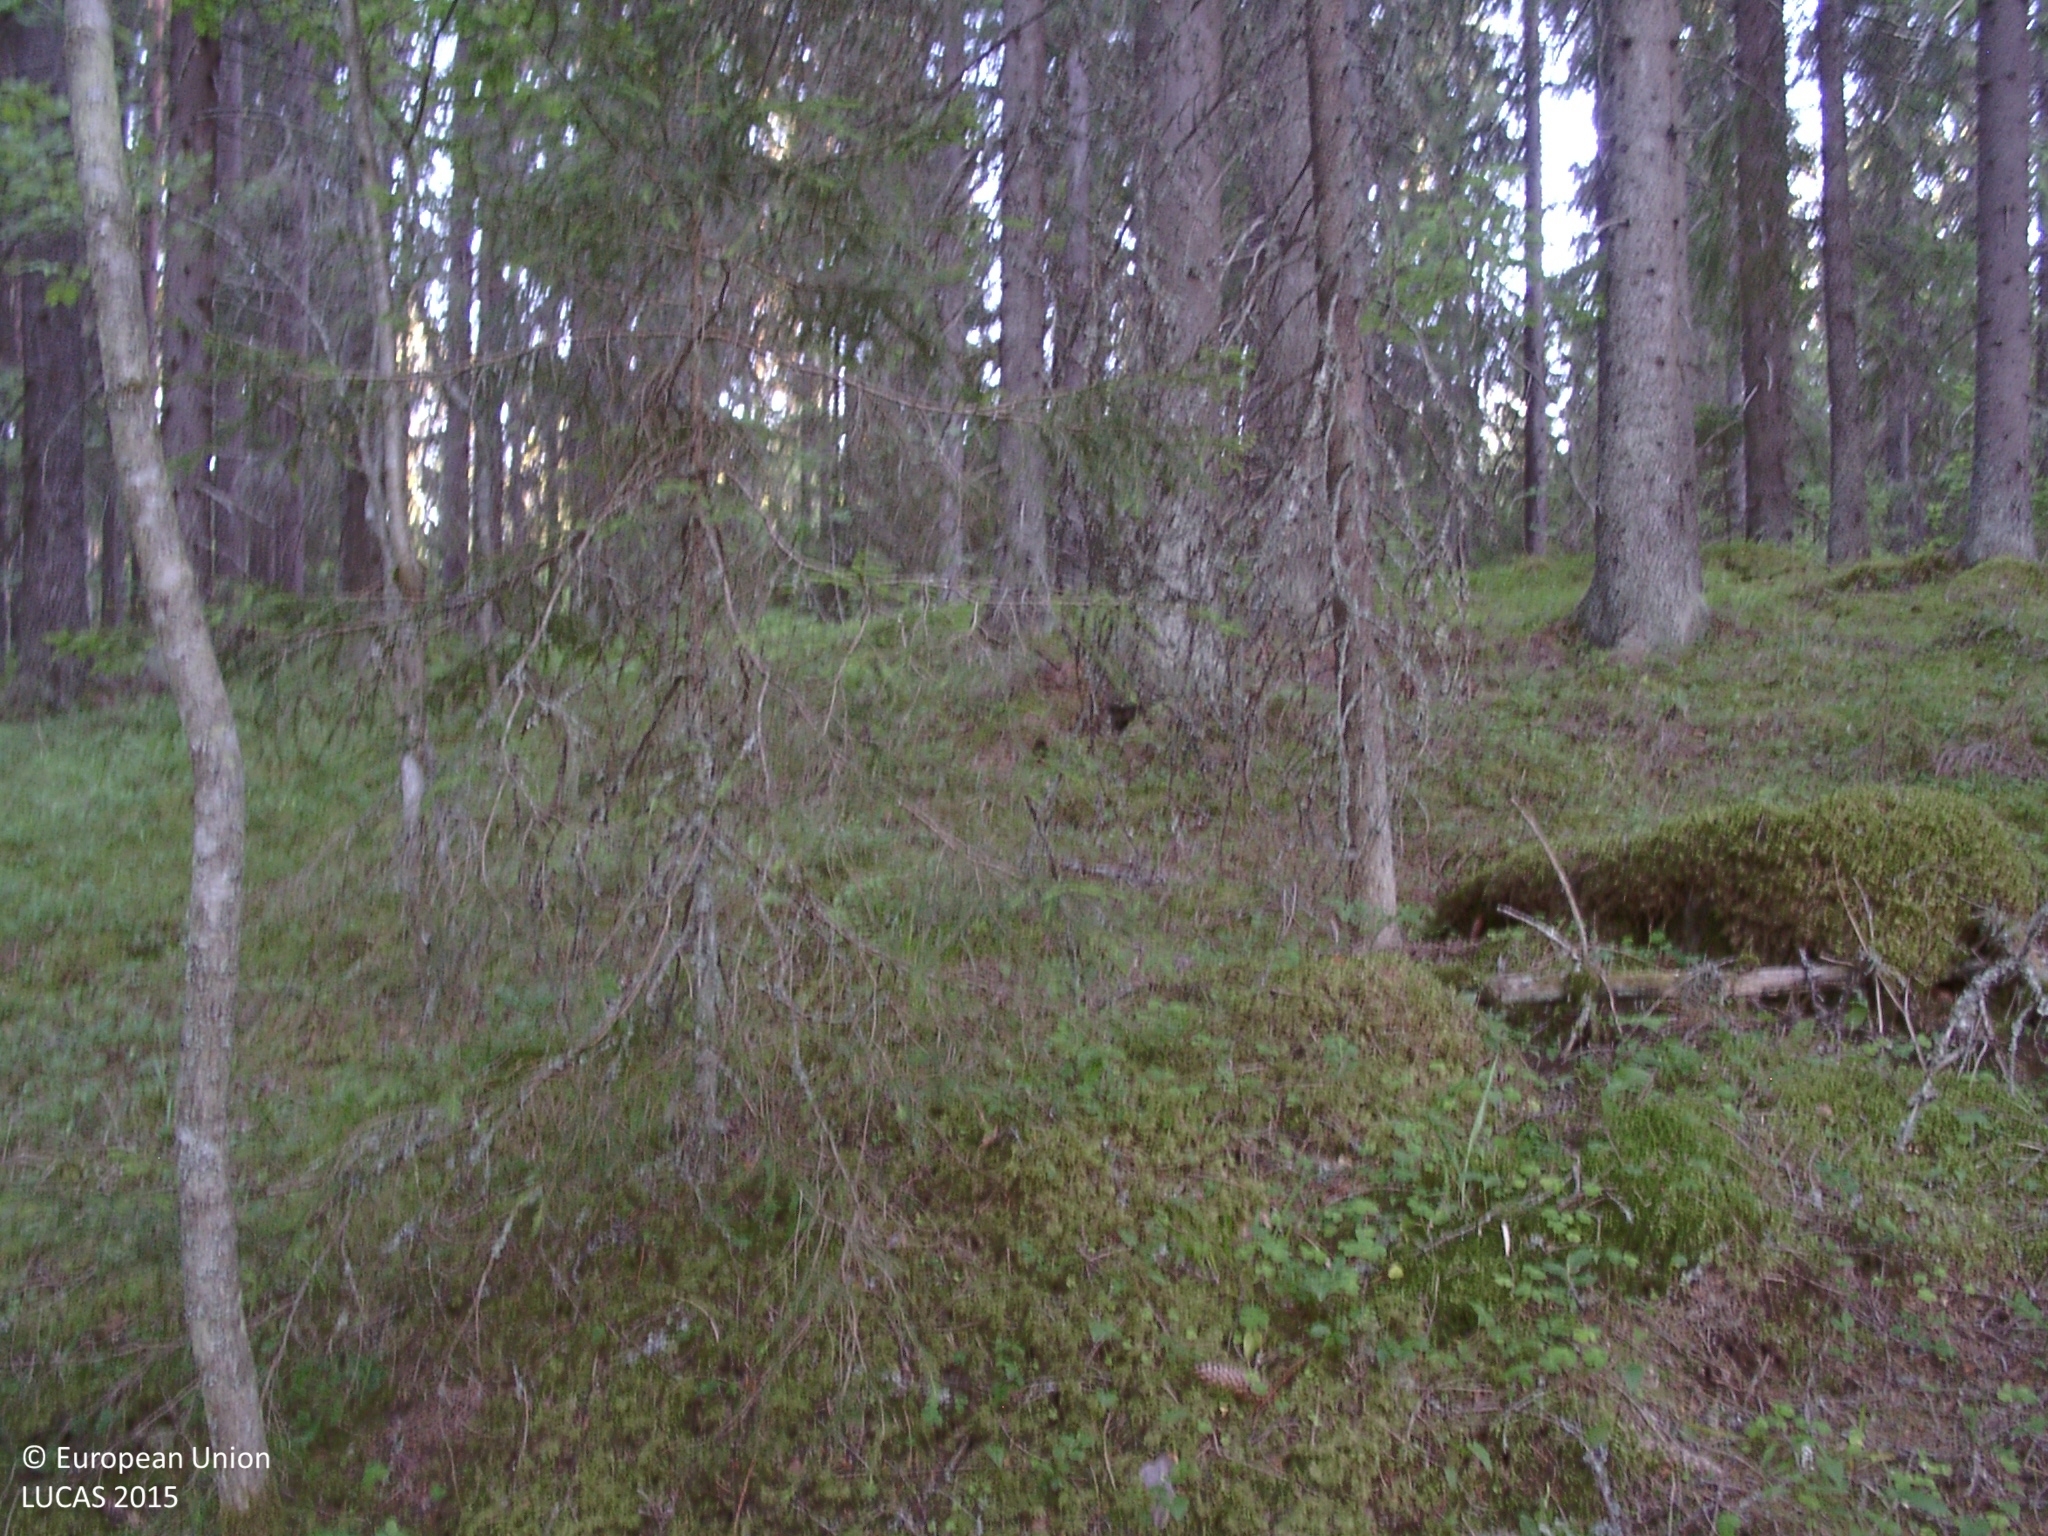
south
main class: Woodland
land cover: Spruce dominated coniferous woodland
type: boreal forest
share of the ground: > 75 %
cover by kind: coniferous forest trees 60 %, broadleaved forest trees 15 %, shrubs 10 %, lichens and mosses 10 %, herbaceous plants 5 %
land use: Forestry
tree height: > 5 m
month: July
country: FI
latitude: 62.0938
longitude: 25.5344
